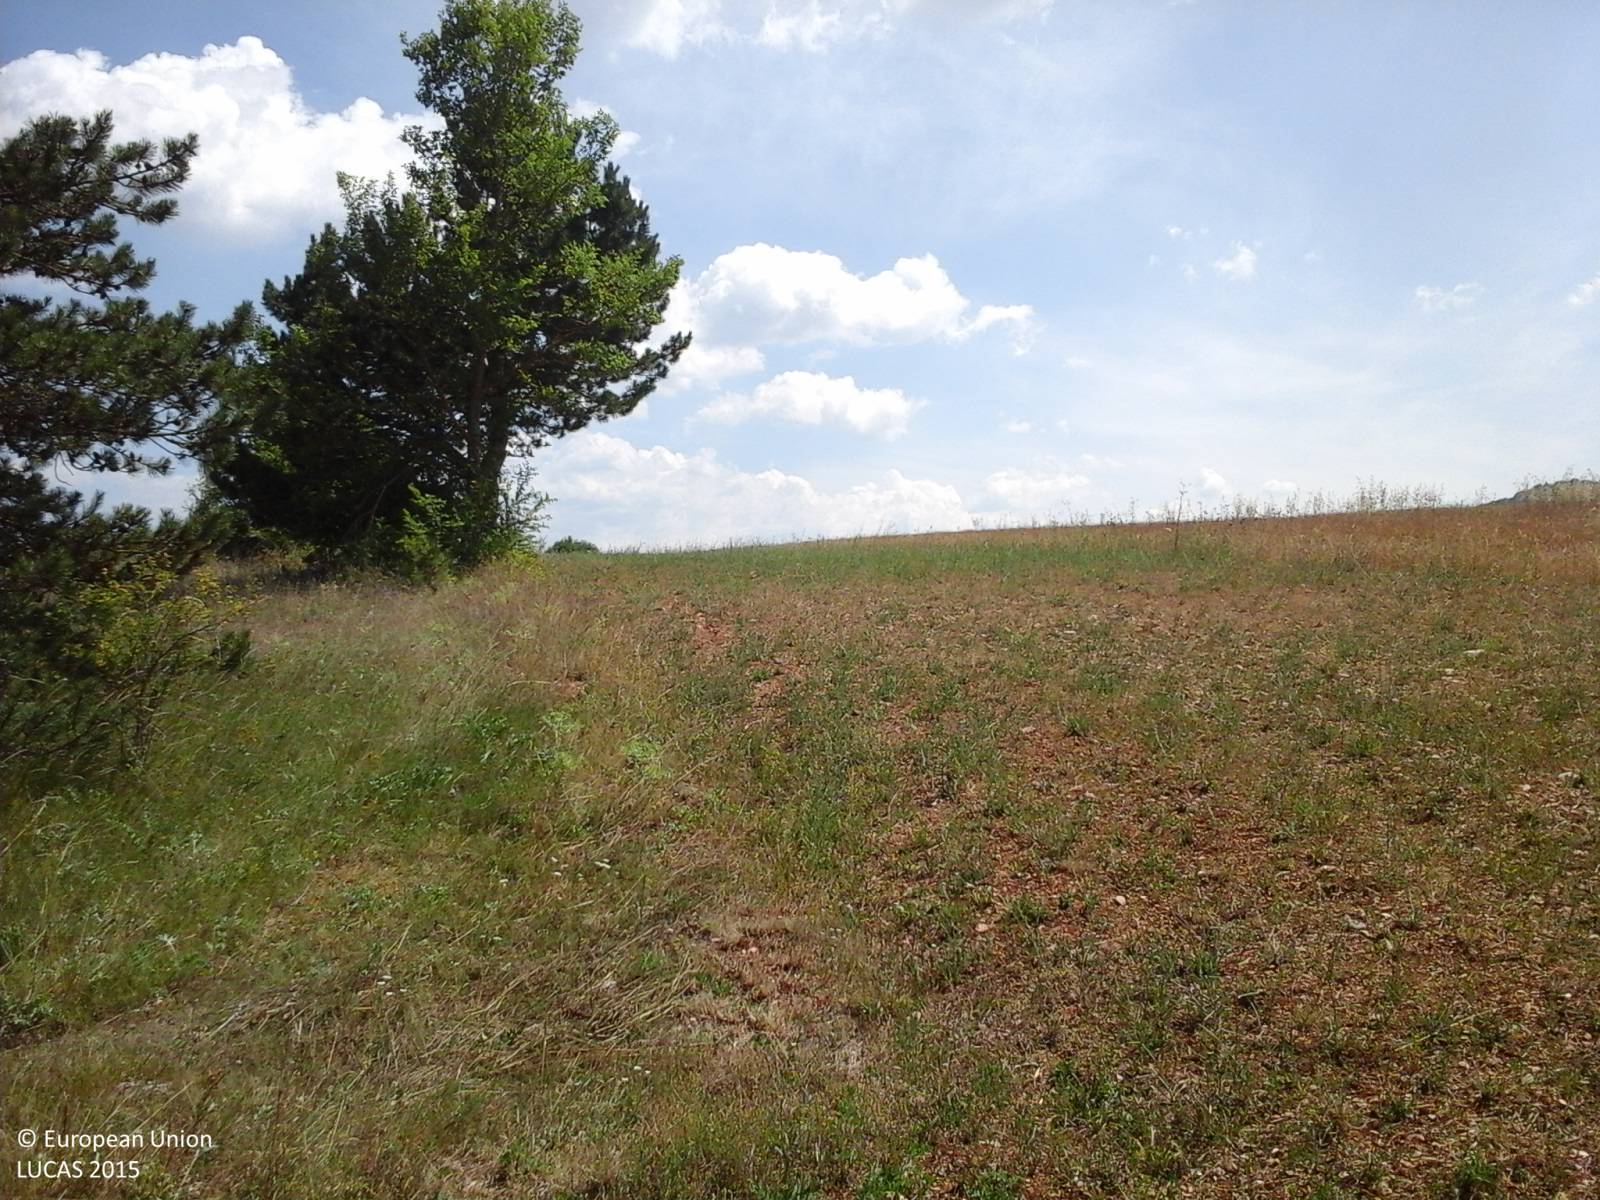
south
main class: Cropland
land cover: Lucerne
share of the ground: > 75 %
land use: Agriculture (excluding fallow land and kitchen gardens)
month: July
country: IT
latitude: 42.4193
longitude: 13.3072
